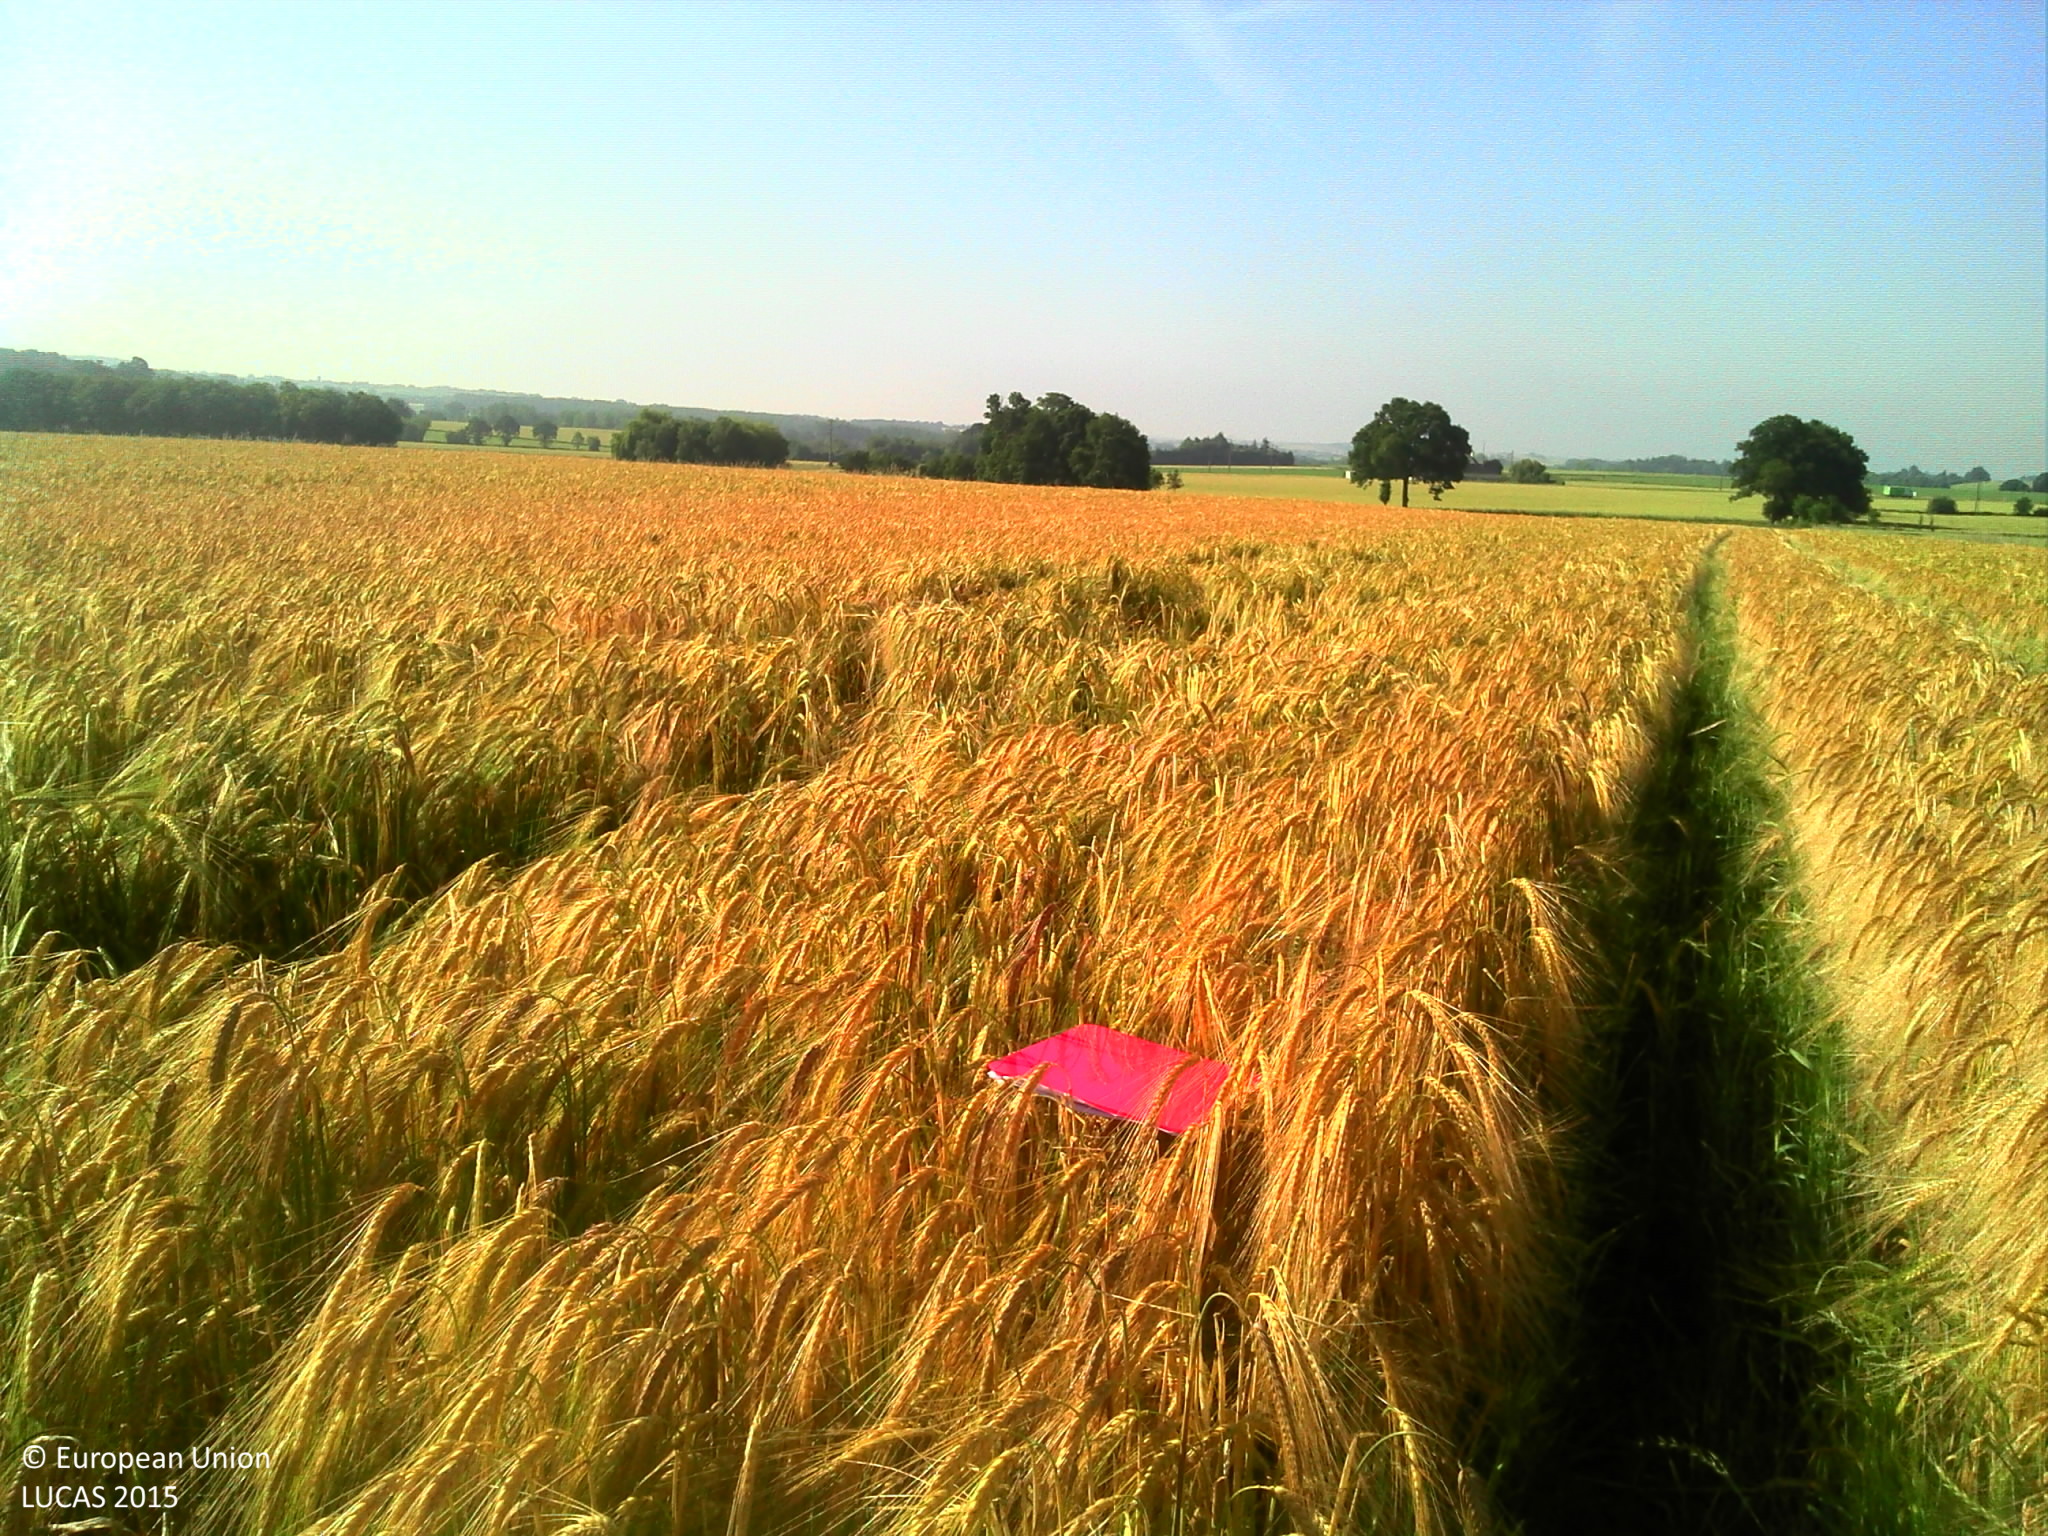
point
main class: Cropland
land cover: Barley
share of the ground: > 75 %
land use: Agriculture (excluding fallow land and kitchen gardens)
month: June
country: FR
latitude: 48.0063
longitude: -1.4515
